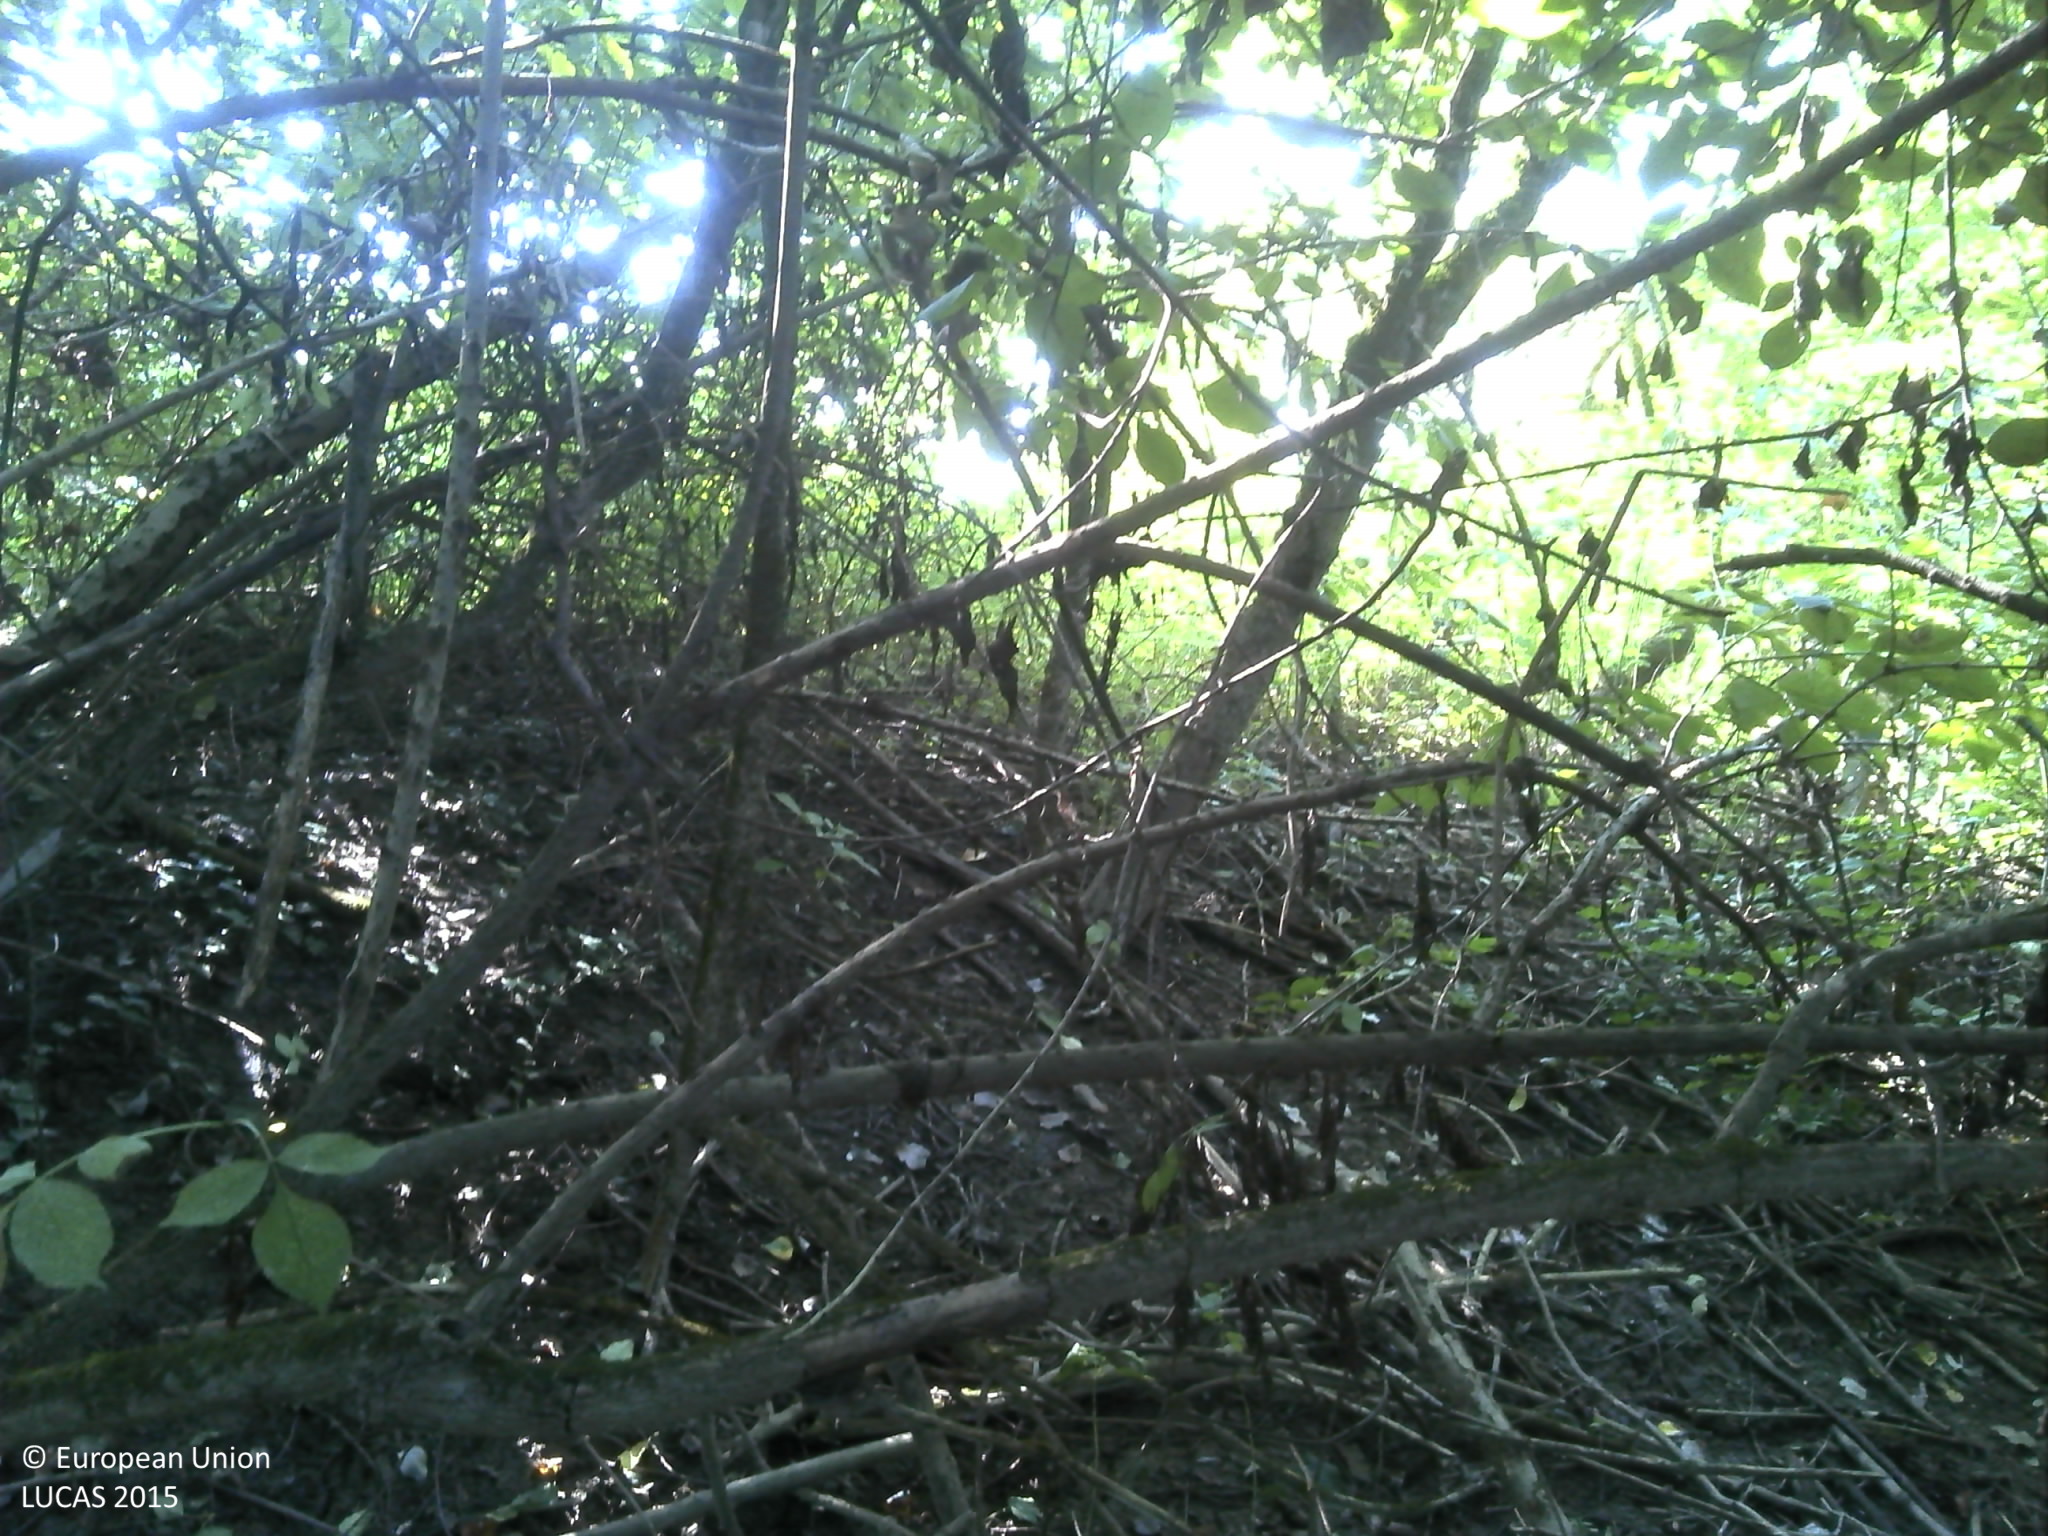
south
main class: Woodland
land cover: Broadleaved woodland
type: mesophytic deciduous forest
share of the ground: > 75 %
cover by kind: broadleaved forest trees 100 %
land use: Forestry
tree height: > 5 m
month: September
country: HR
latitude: 45.6206
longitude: 16.3466
